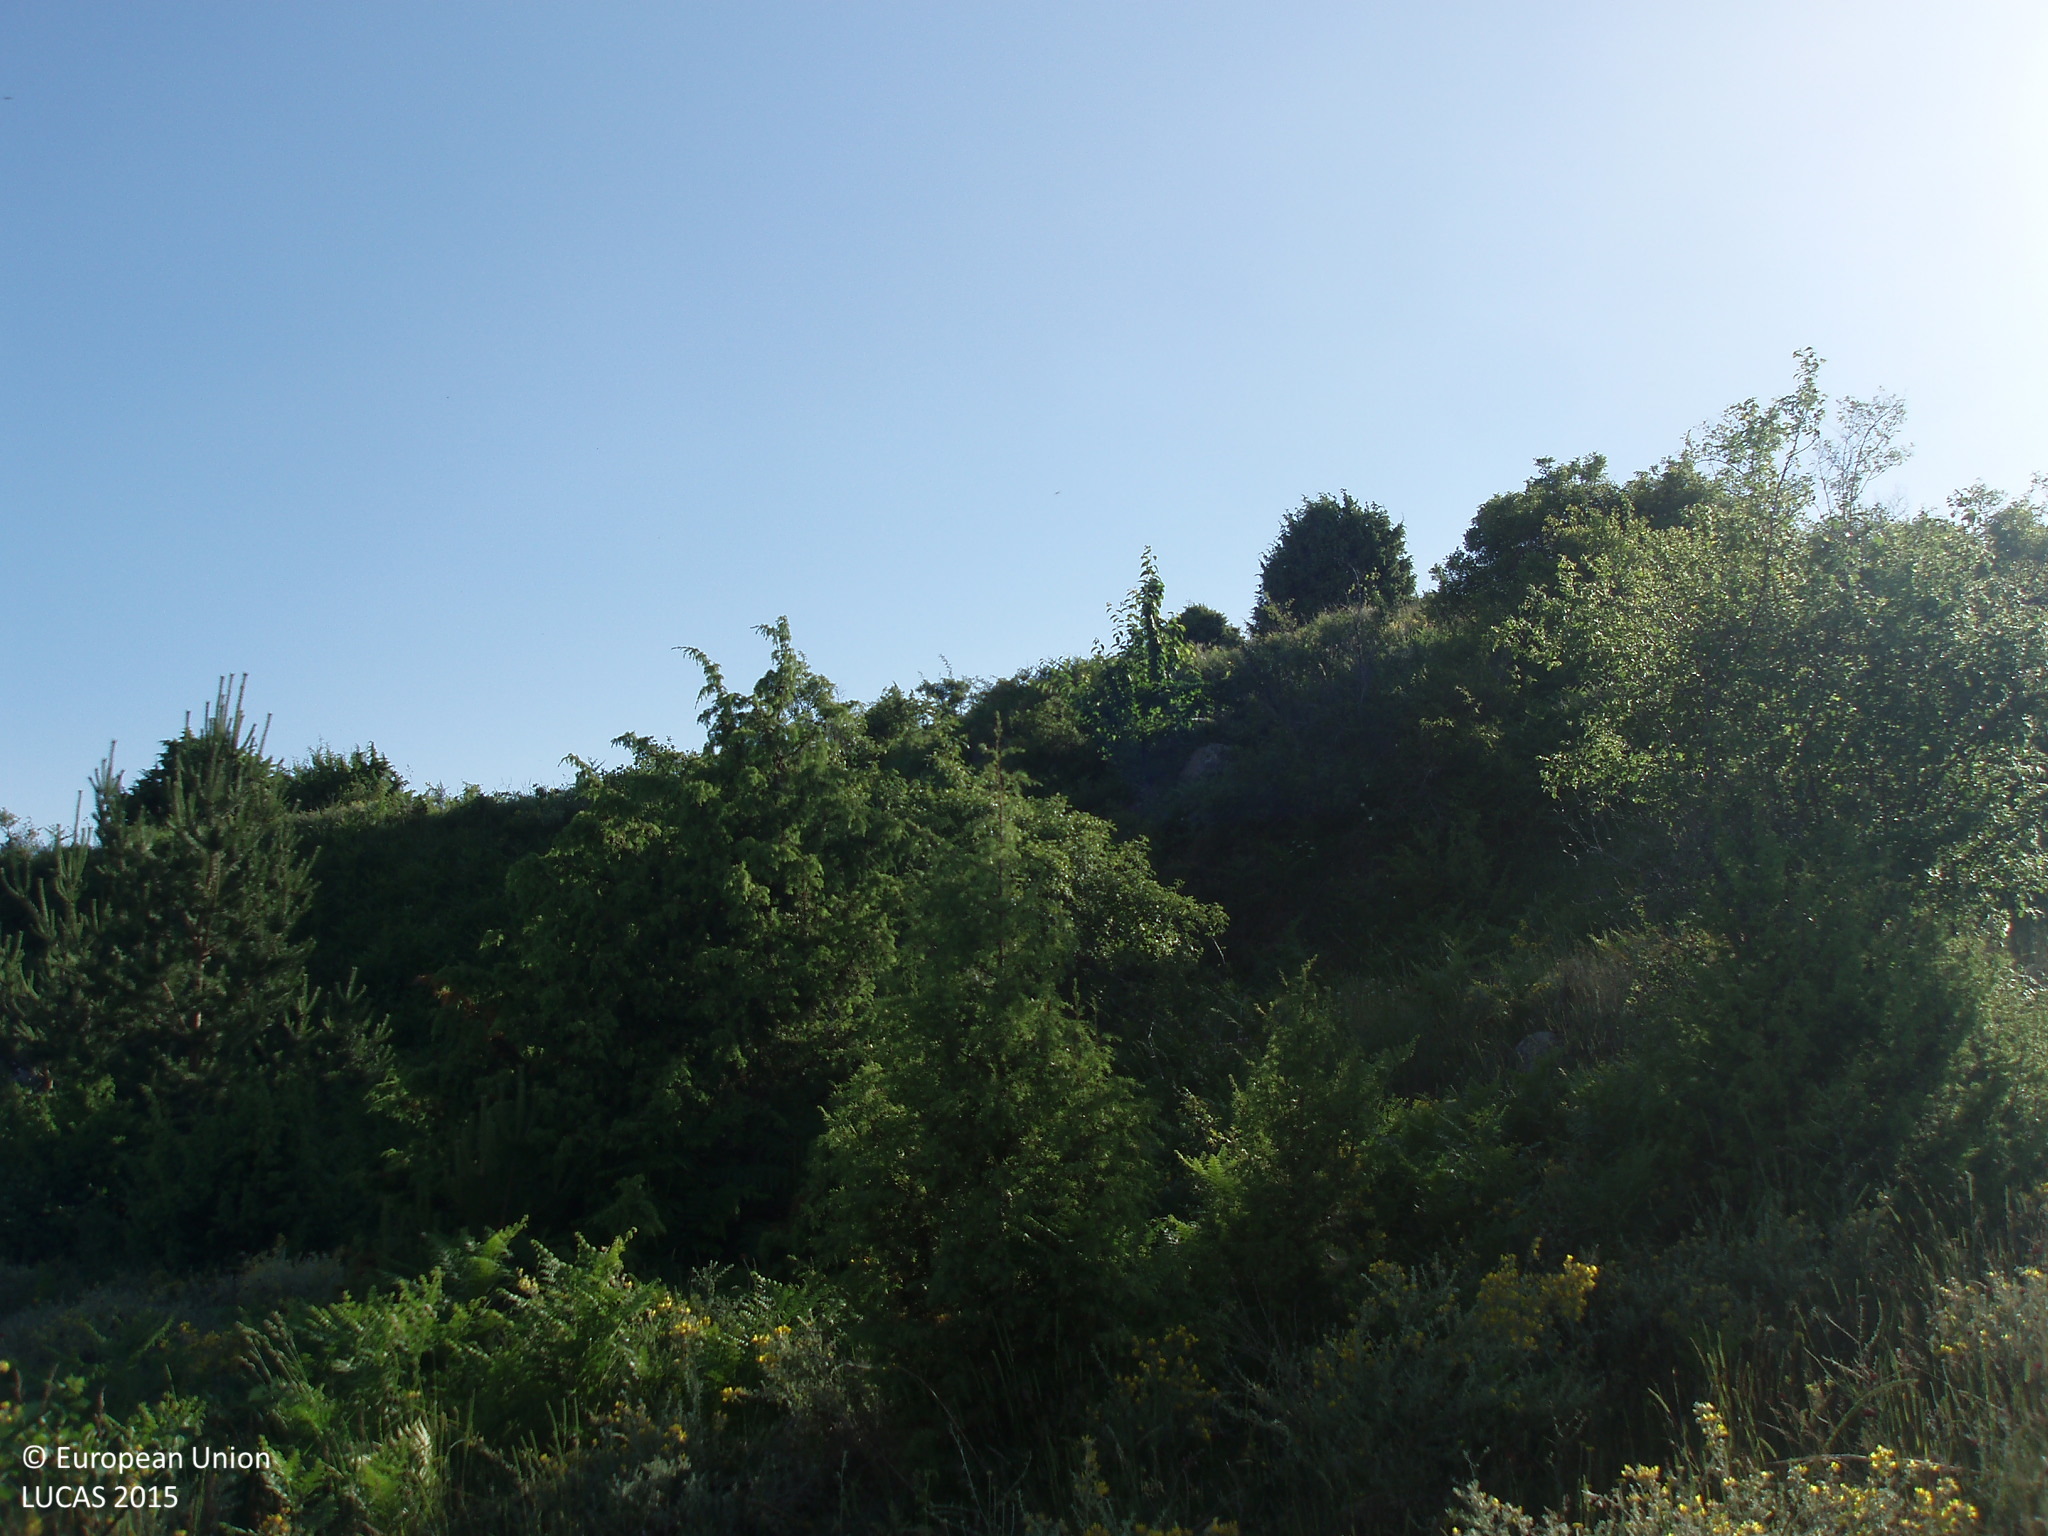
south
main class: Shrubland
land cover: Shrubland with sparse tree cover
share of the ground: 50 - 75 %
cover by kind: shrubs 65 %, herbaceous plants 30 %, broadleaved forest trees 5 %
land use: Semi-natural and natural areas not in use
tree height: < 5 m
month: June
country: BG
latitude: 41.4960
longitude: 23.7189
